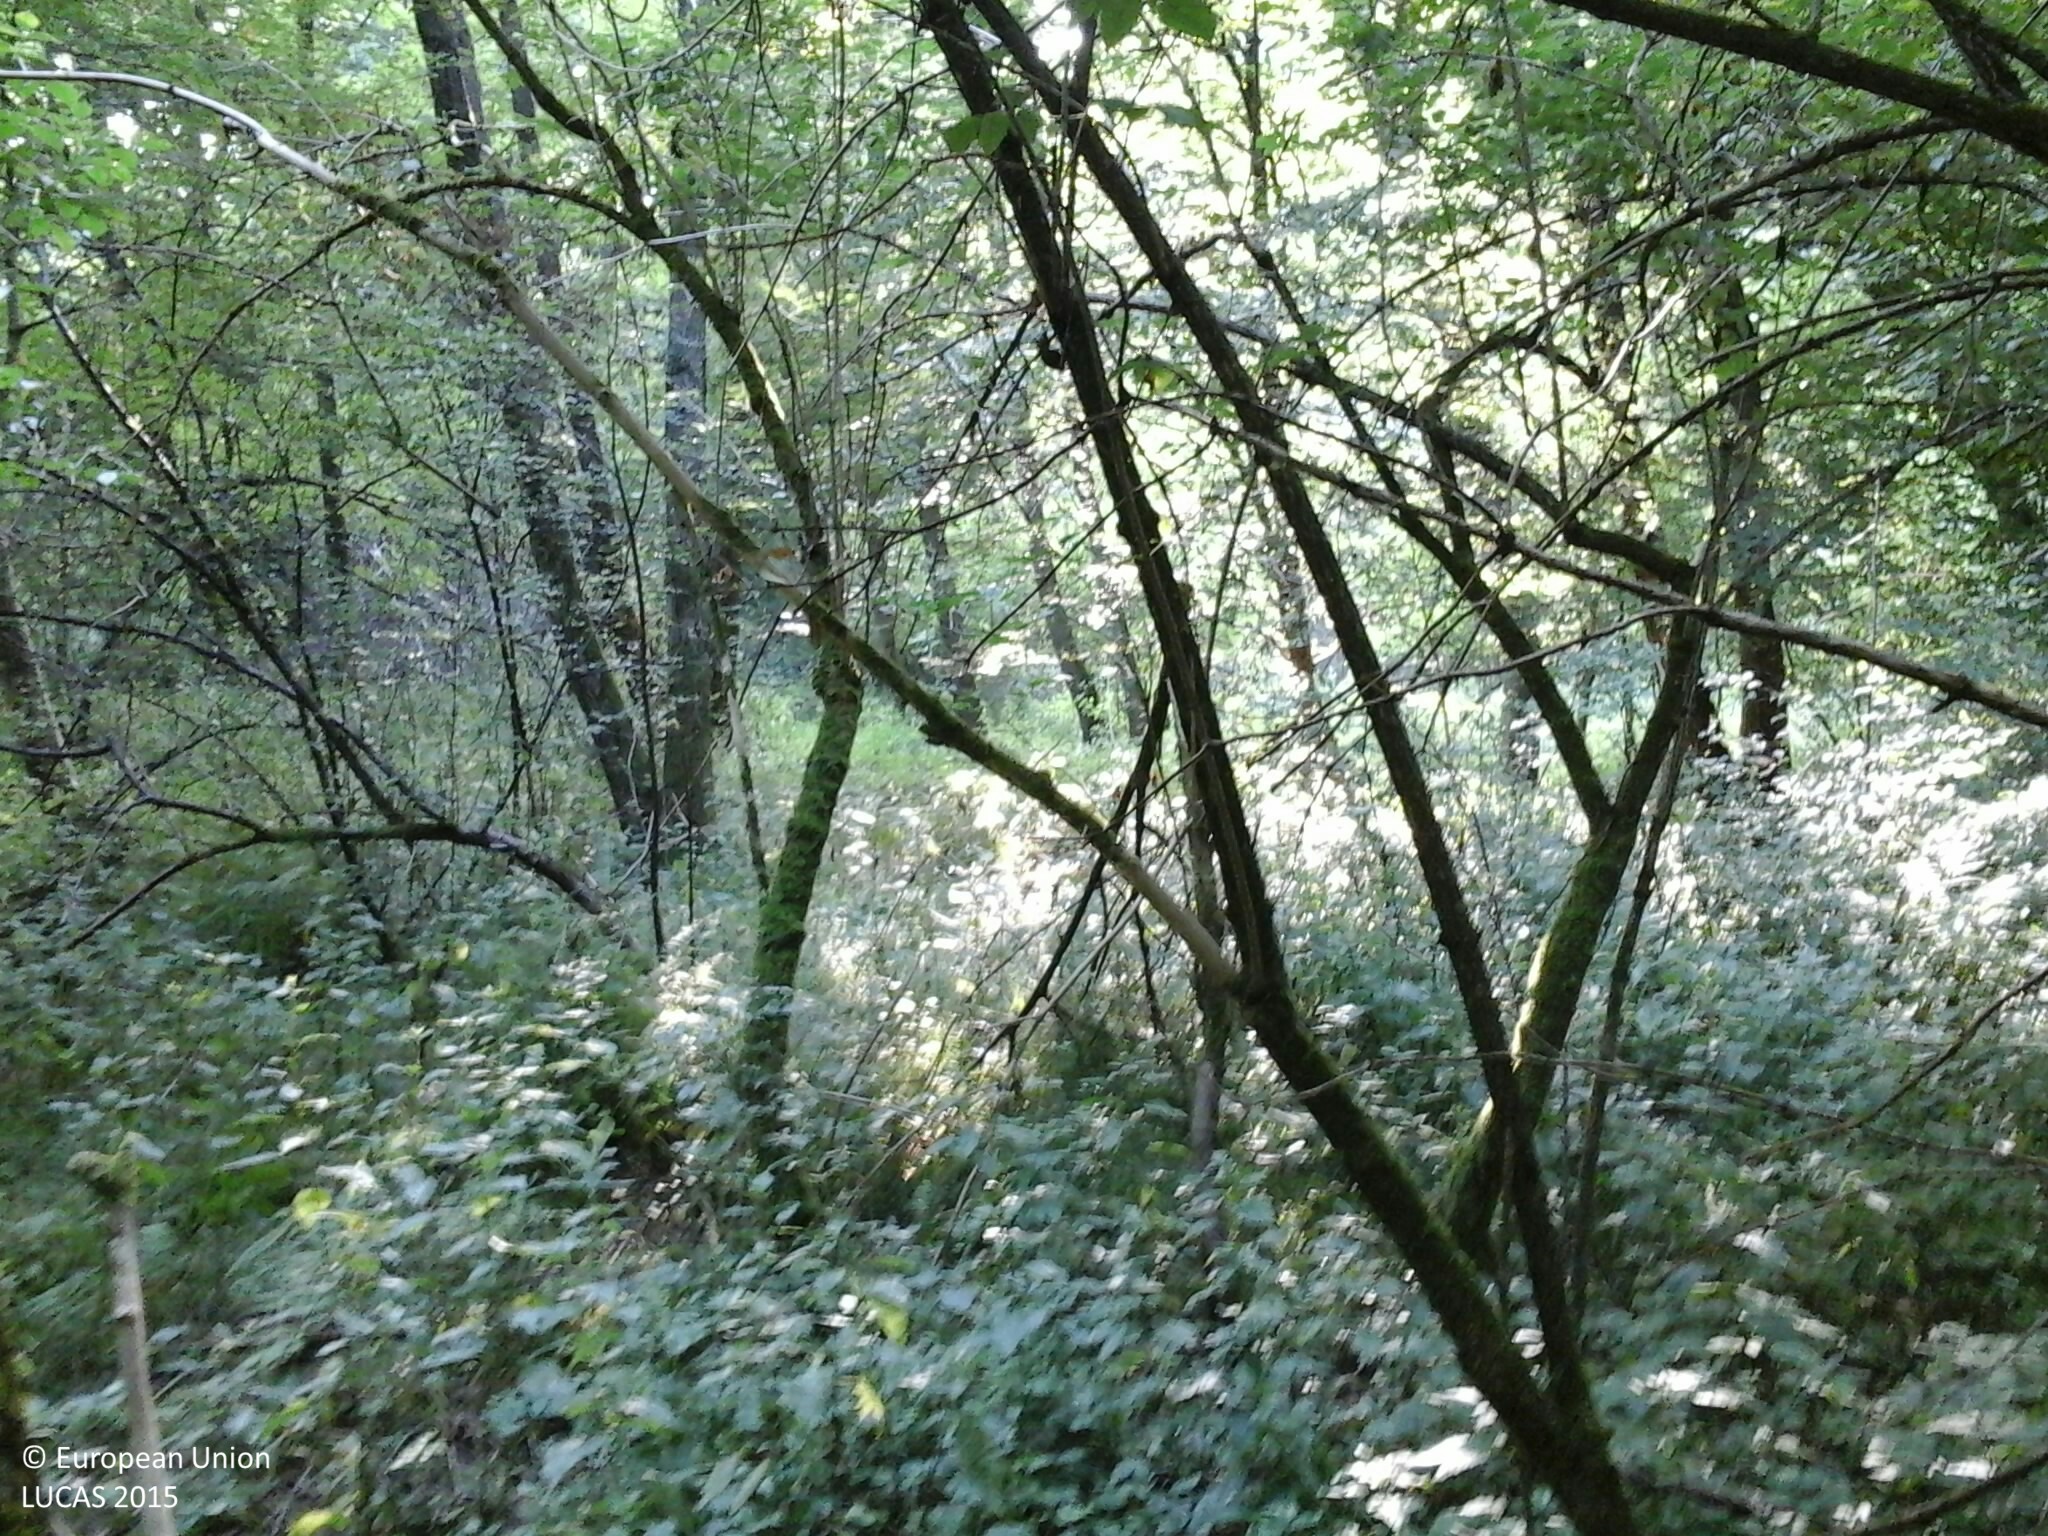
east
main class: Woodland
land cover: Broadleaved woodland
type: mesophytic deciduous forest
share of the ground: > 75 %
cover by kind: broadleaved forest trees 85 %, shrubs 10 %, herbaceous plants 5 %
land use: Forestry
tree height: > 5 m
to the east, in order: Broadleaved woodland; Shrubland with sparse tree cover; Broadleaved woodland; Tracks; Broadleaved woodland
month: July
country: HU
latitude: 46.9479
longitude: 16.5059
